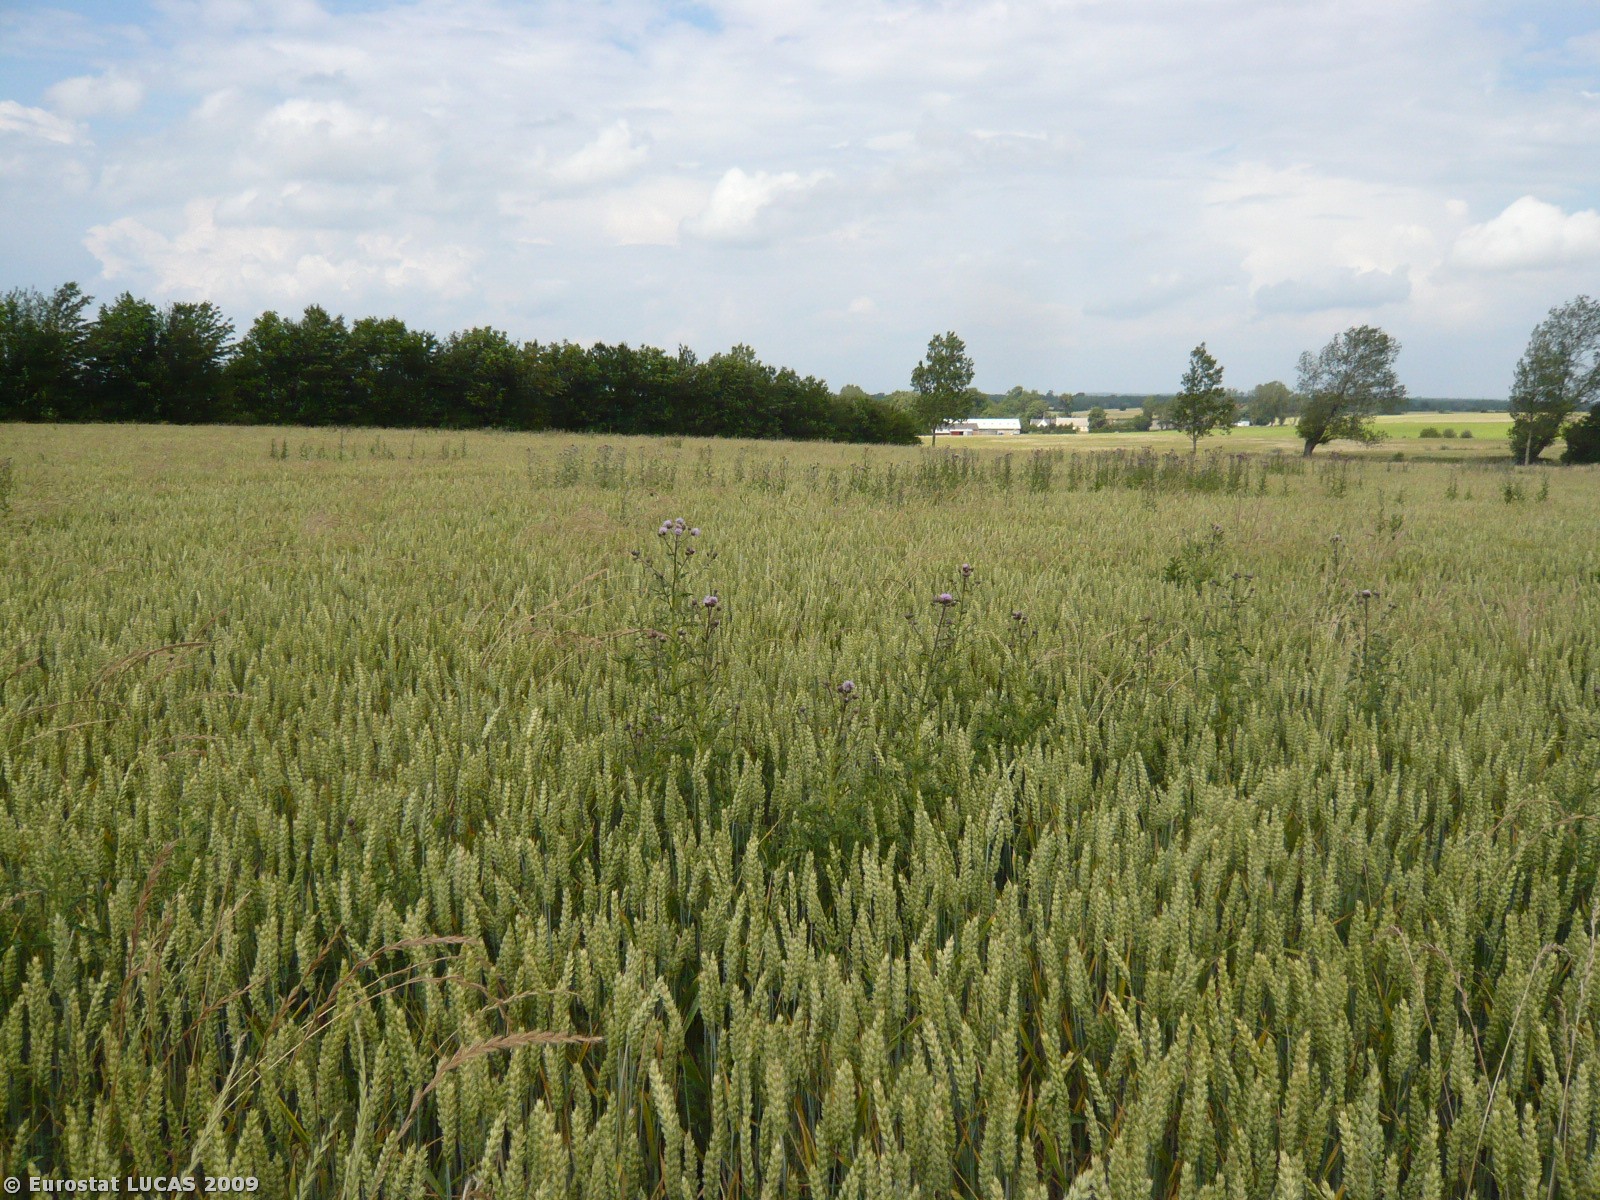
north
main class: Cropland
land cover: Common wheat
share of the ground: > 75 %
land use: Agriculture (excluding fallow land and kitchen gardens)
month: July
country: DK
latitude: 55.5226
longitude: 10.1424
